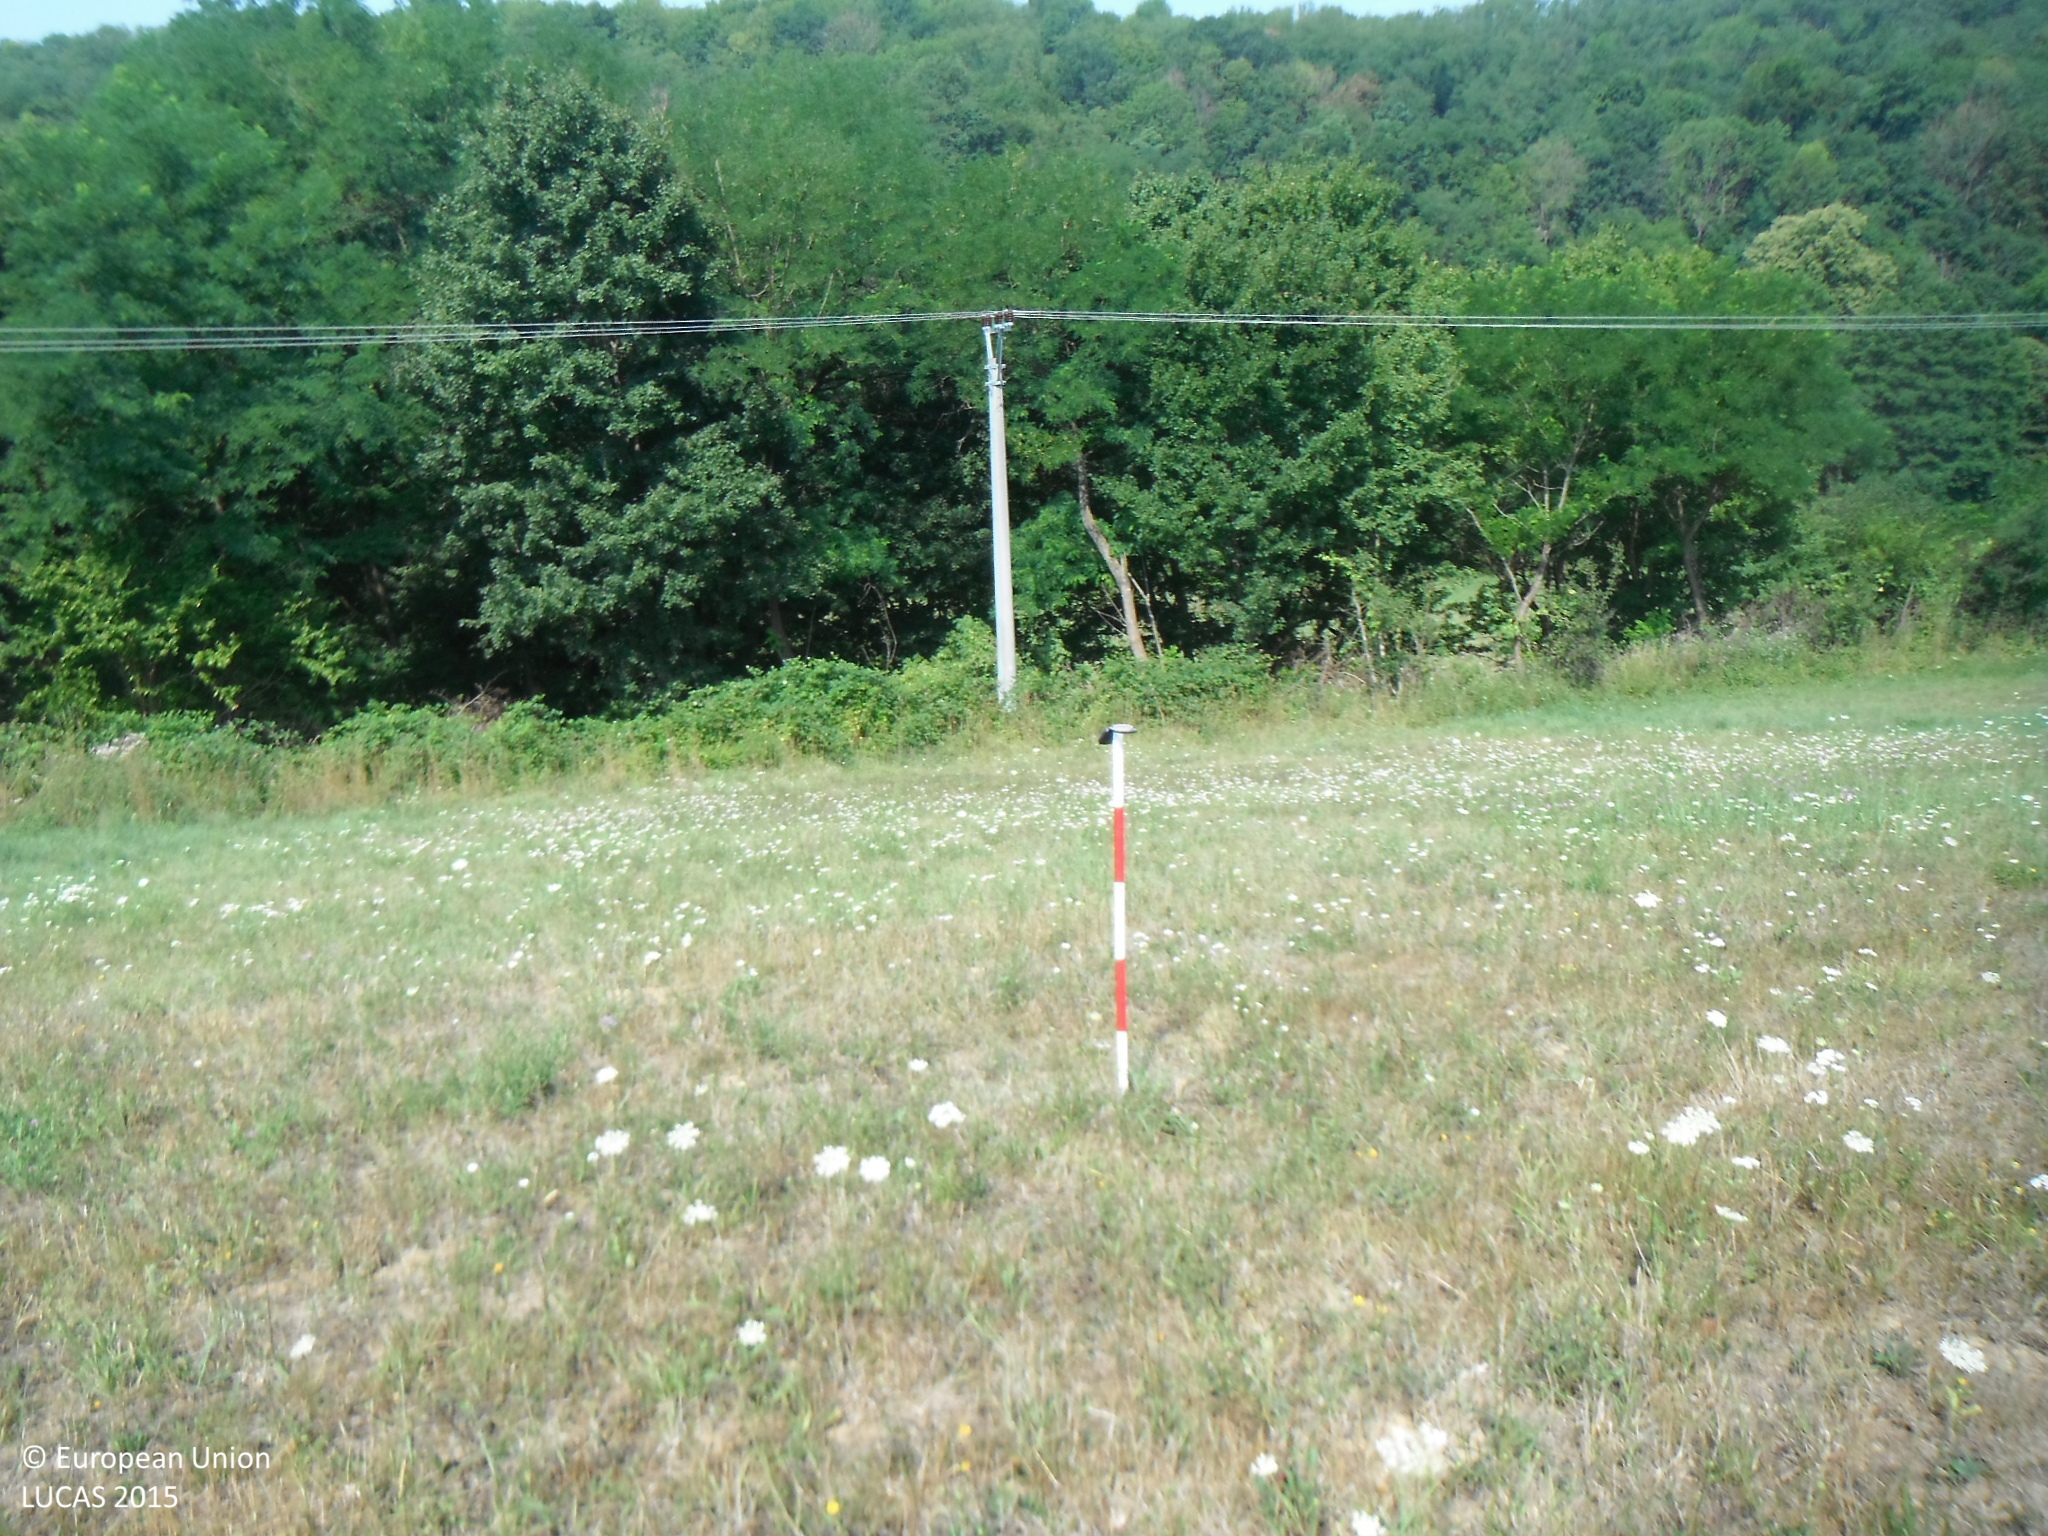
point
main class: Grassland
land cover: Grassland without tree/shrub cover
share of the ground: > 75 %
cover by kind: herbaceous plants 100 %
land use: Agriculture (excluding fallow land and kitchen gardens)
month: July
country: SK
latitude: 48.6748
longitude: 17.4665
